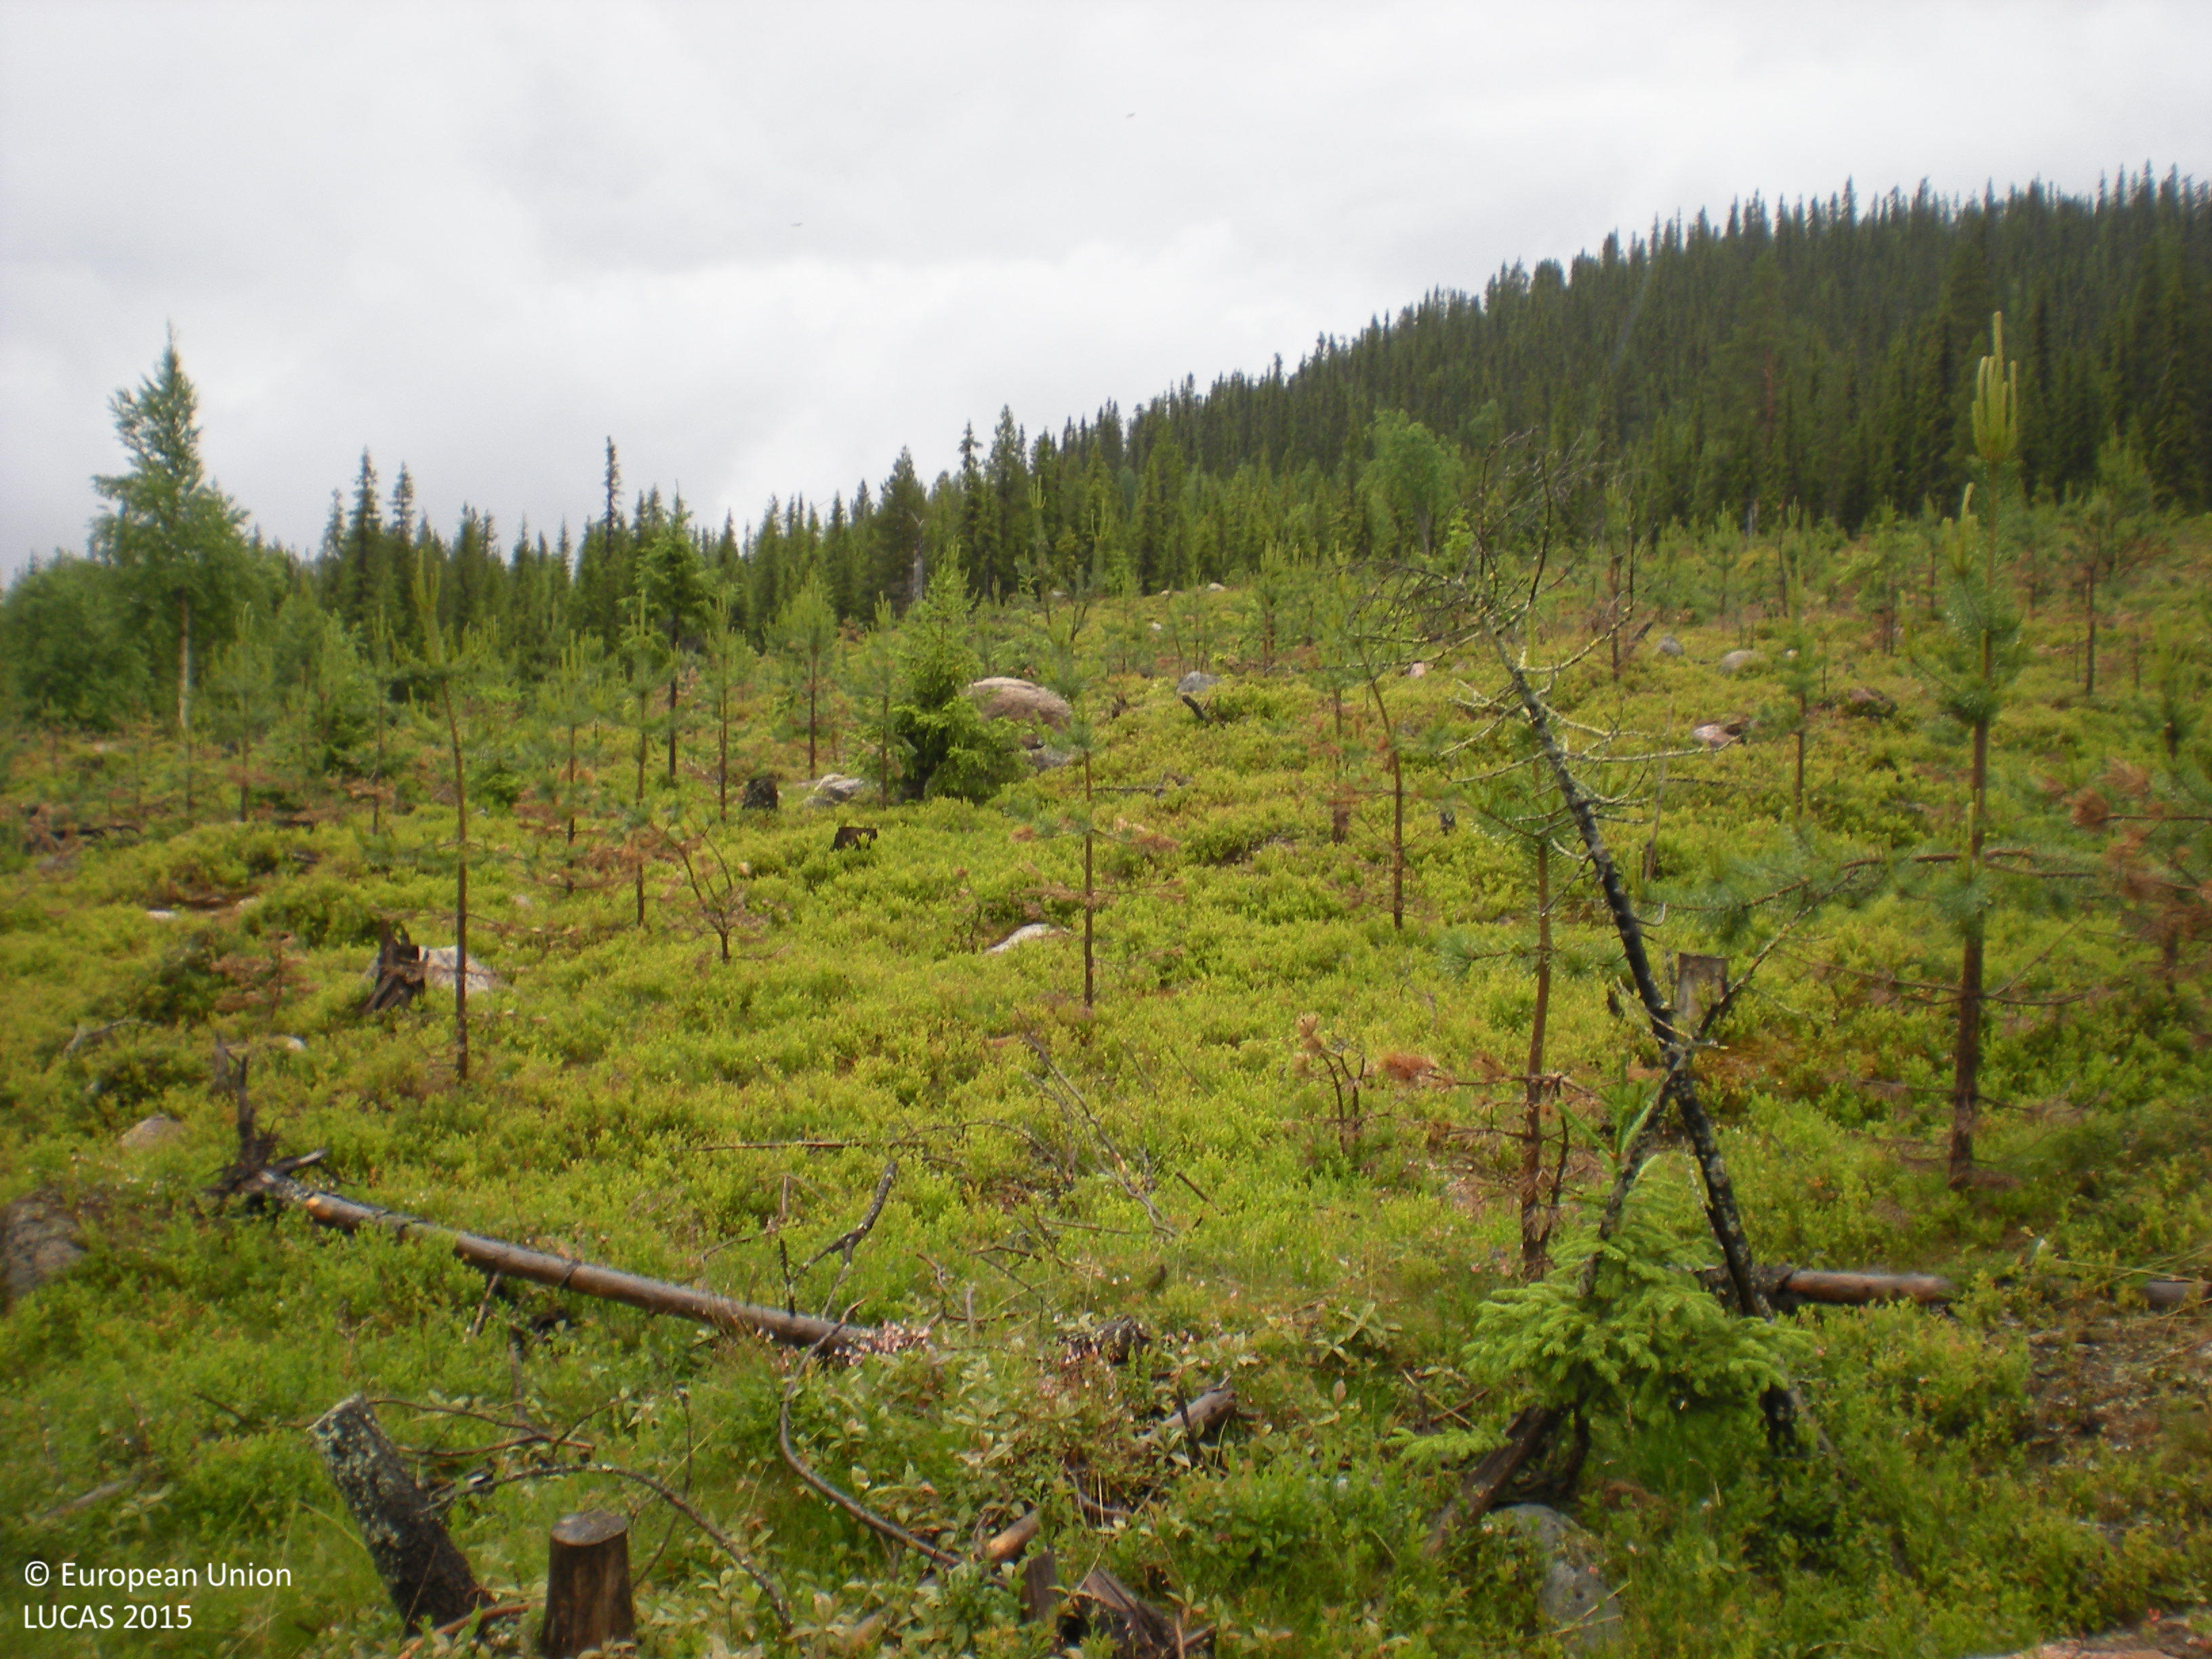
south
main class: Woodland
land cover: Pine dominated coniferous woodland
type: boreal forest
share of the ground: 25 - 50 %
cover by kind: shrubs 55 %, coniferous forest trees 30 %, lichens and mosses 10 %, herbaceous plants 5 %
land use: Forestry
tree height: < 5 m
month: July
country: SE
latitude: 65.8449
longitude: 17.7316
